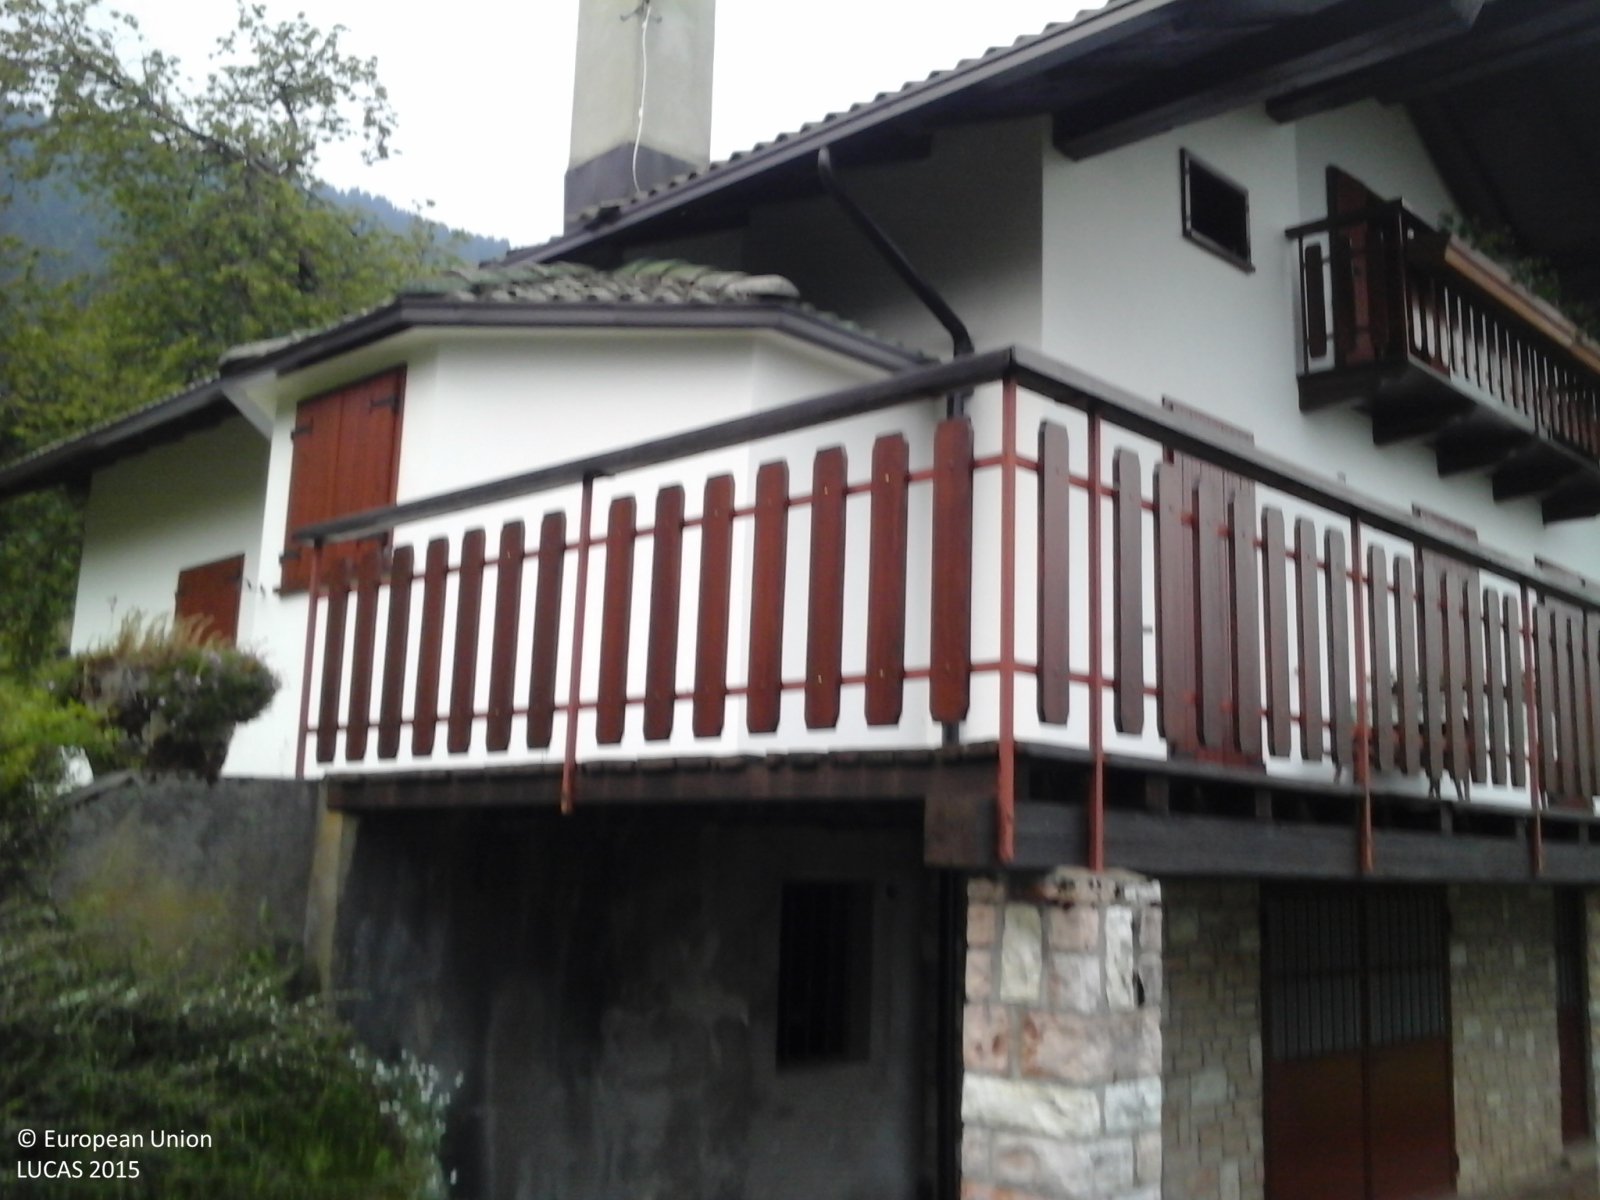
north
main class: Grassland
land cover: Grassland with sparse tree/shrub cover
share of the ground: > 75 %
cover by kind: herbaceous plants 80 %, broadleaved forest trees 5 %
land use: Residential
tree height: > 5 m
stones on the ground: < 10 %
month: May
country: IT
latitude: 46.0667
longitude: 11.7429
